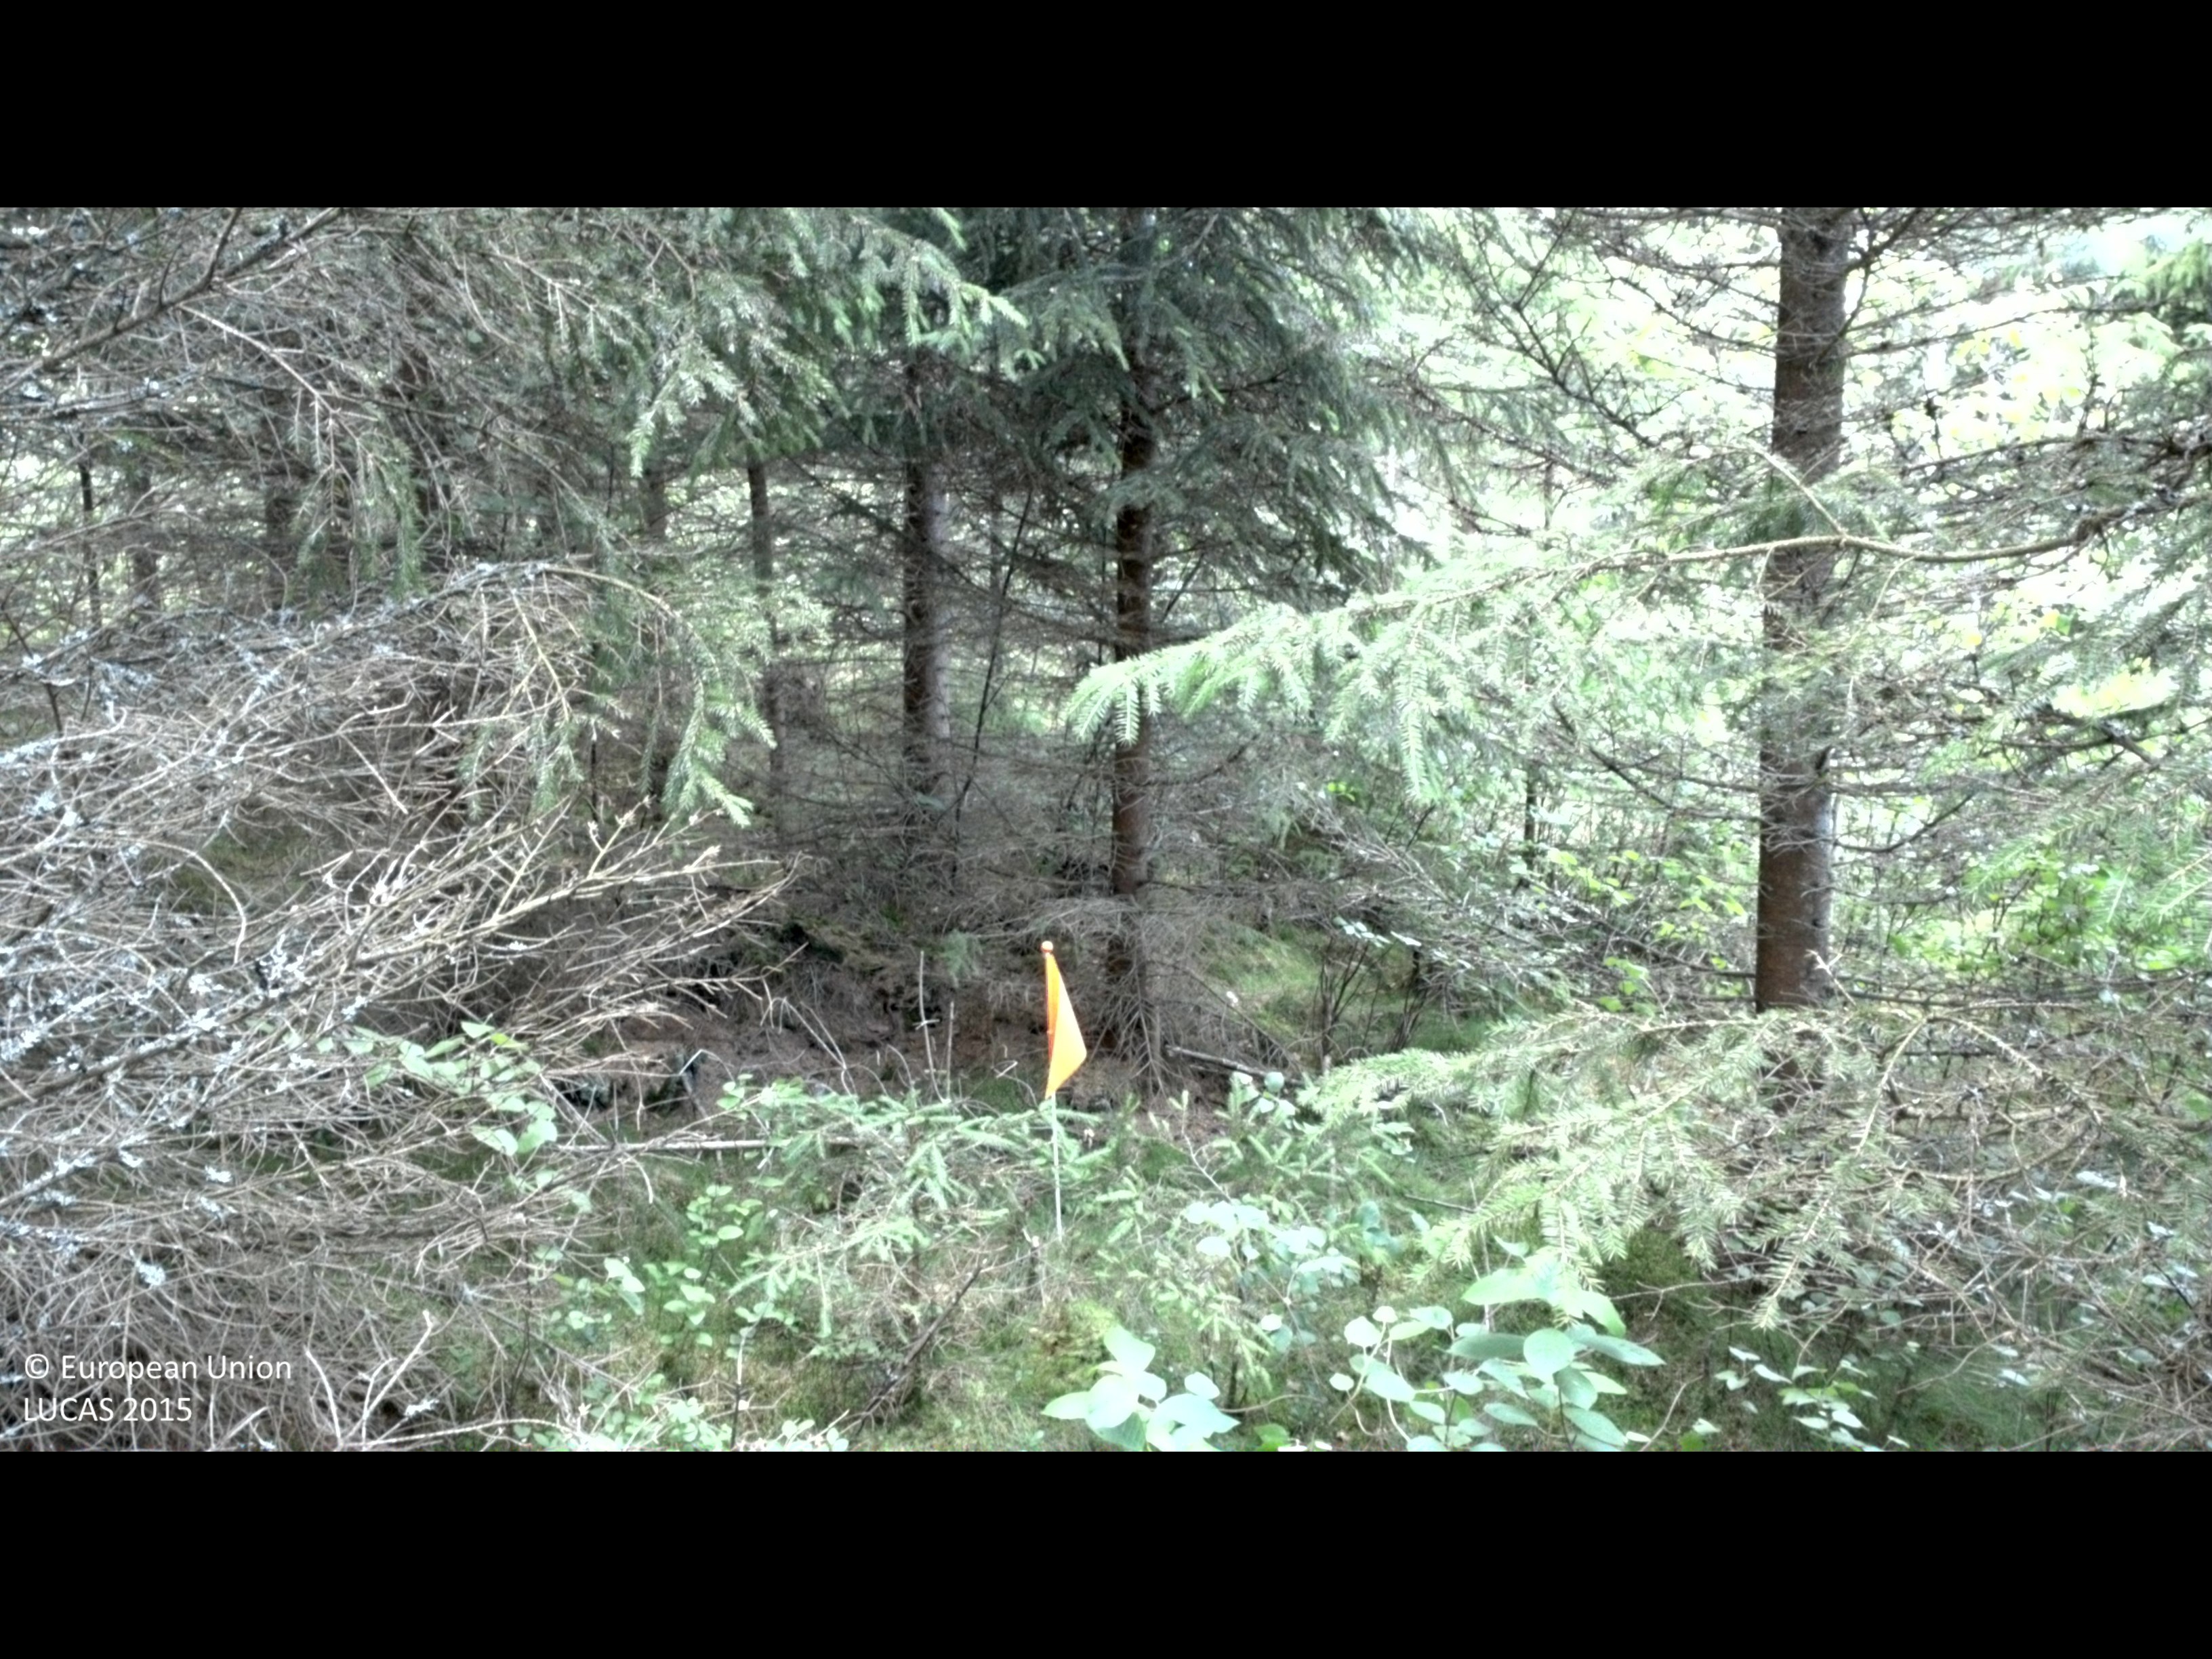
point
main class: Woodland
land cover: Spruce dominated mixed woodland
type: boreal forest
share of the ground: > 75 %
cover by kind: coniferous forest trees 60 %, broadleaved forest trees 20 %, shrubs 20 %
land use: Forestry
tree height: > 5 m
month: July
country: SE
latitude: 56.4911
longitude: 13.8138
